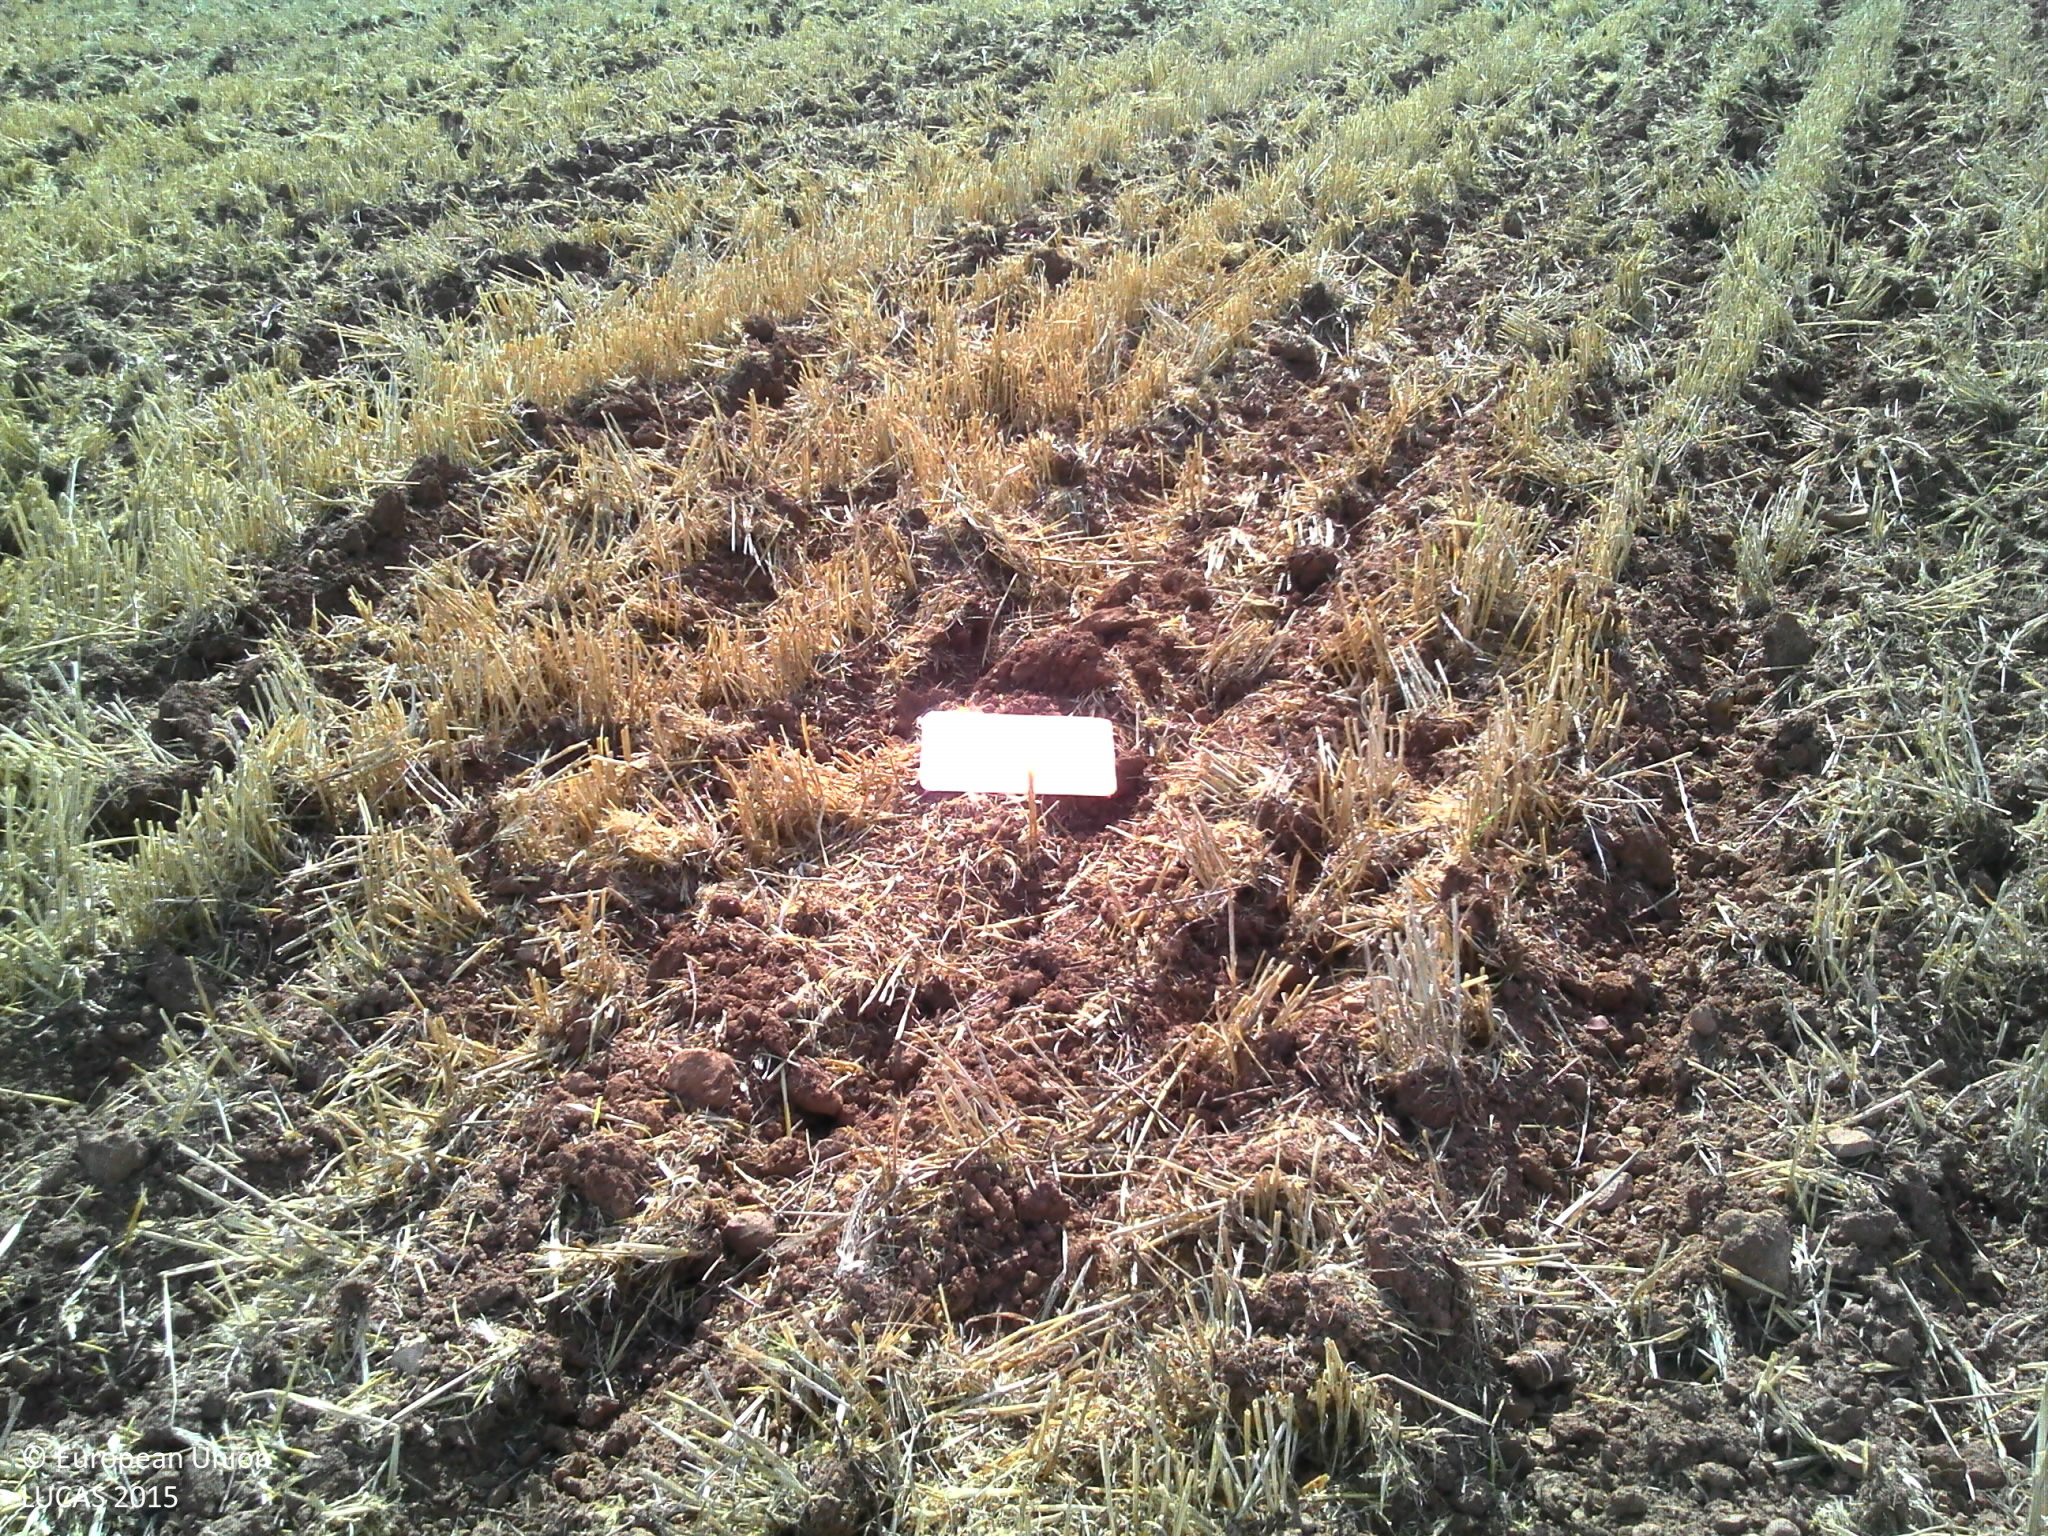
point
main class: Cropland
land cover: Barley
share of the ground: < 10 %
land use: Agriculture (excluding fallow land and kitchen gardens)
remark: Harvested field
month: June
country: FR
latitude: 46.4875
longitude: 0.2755
